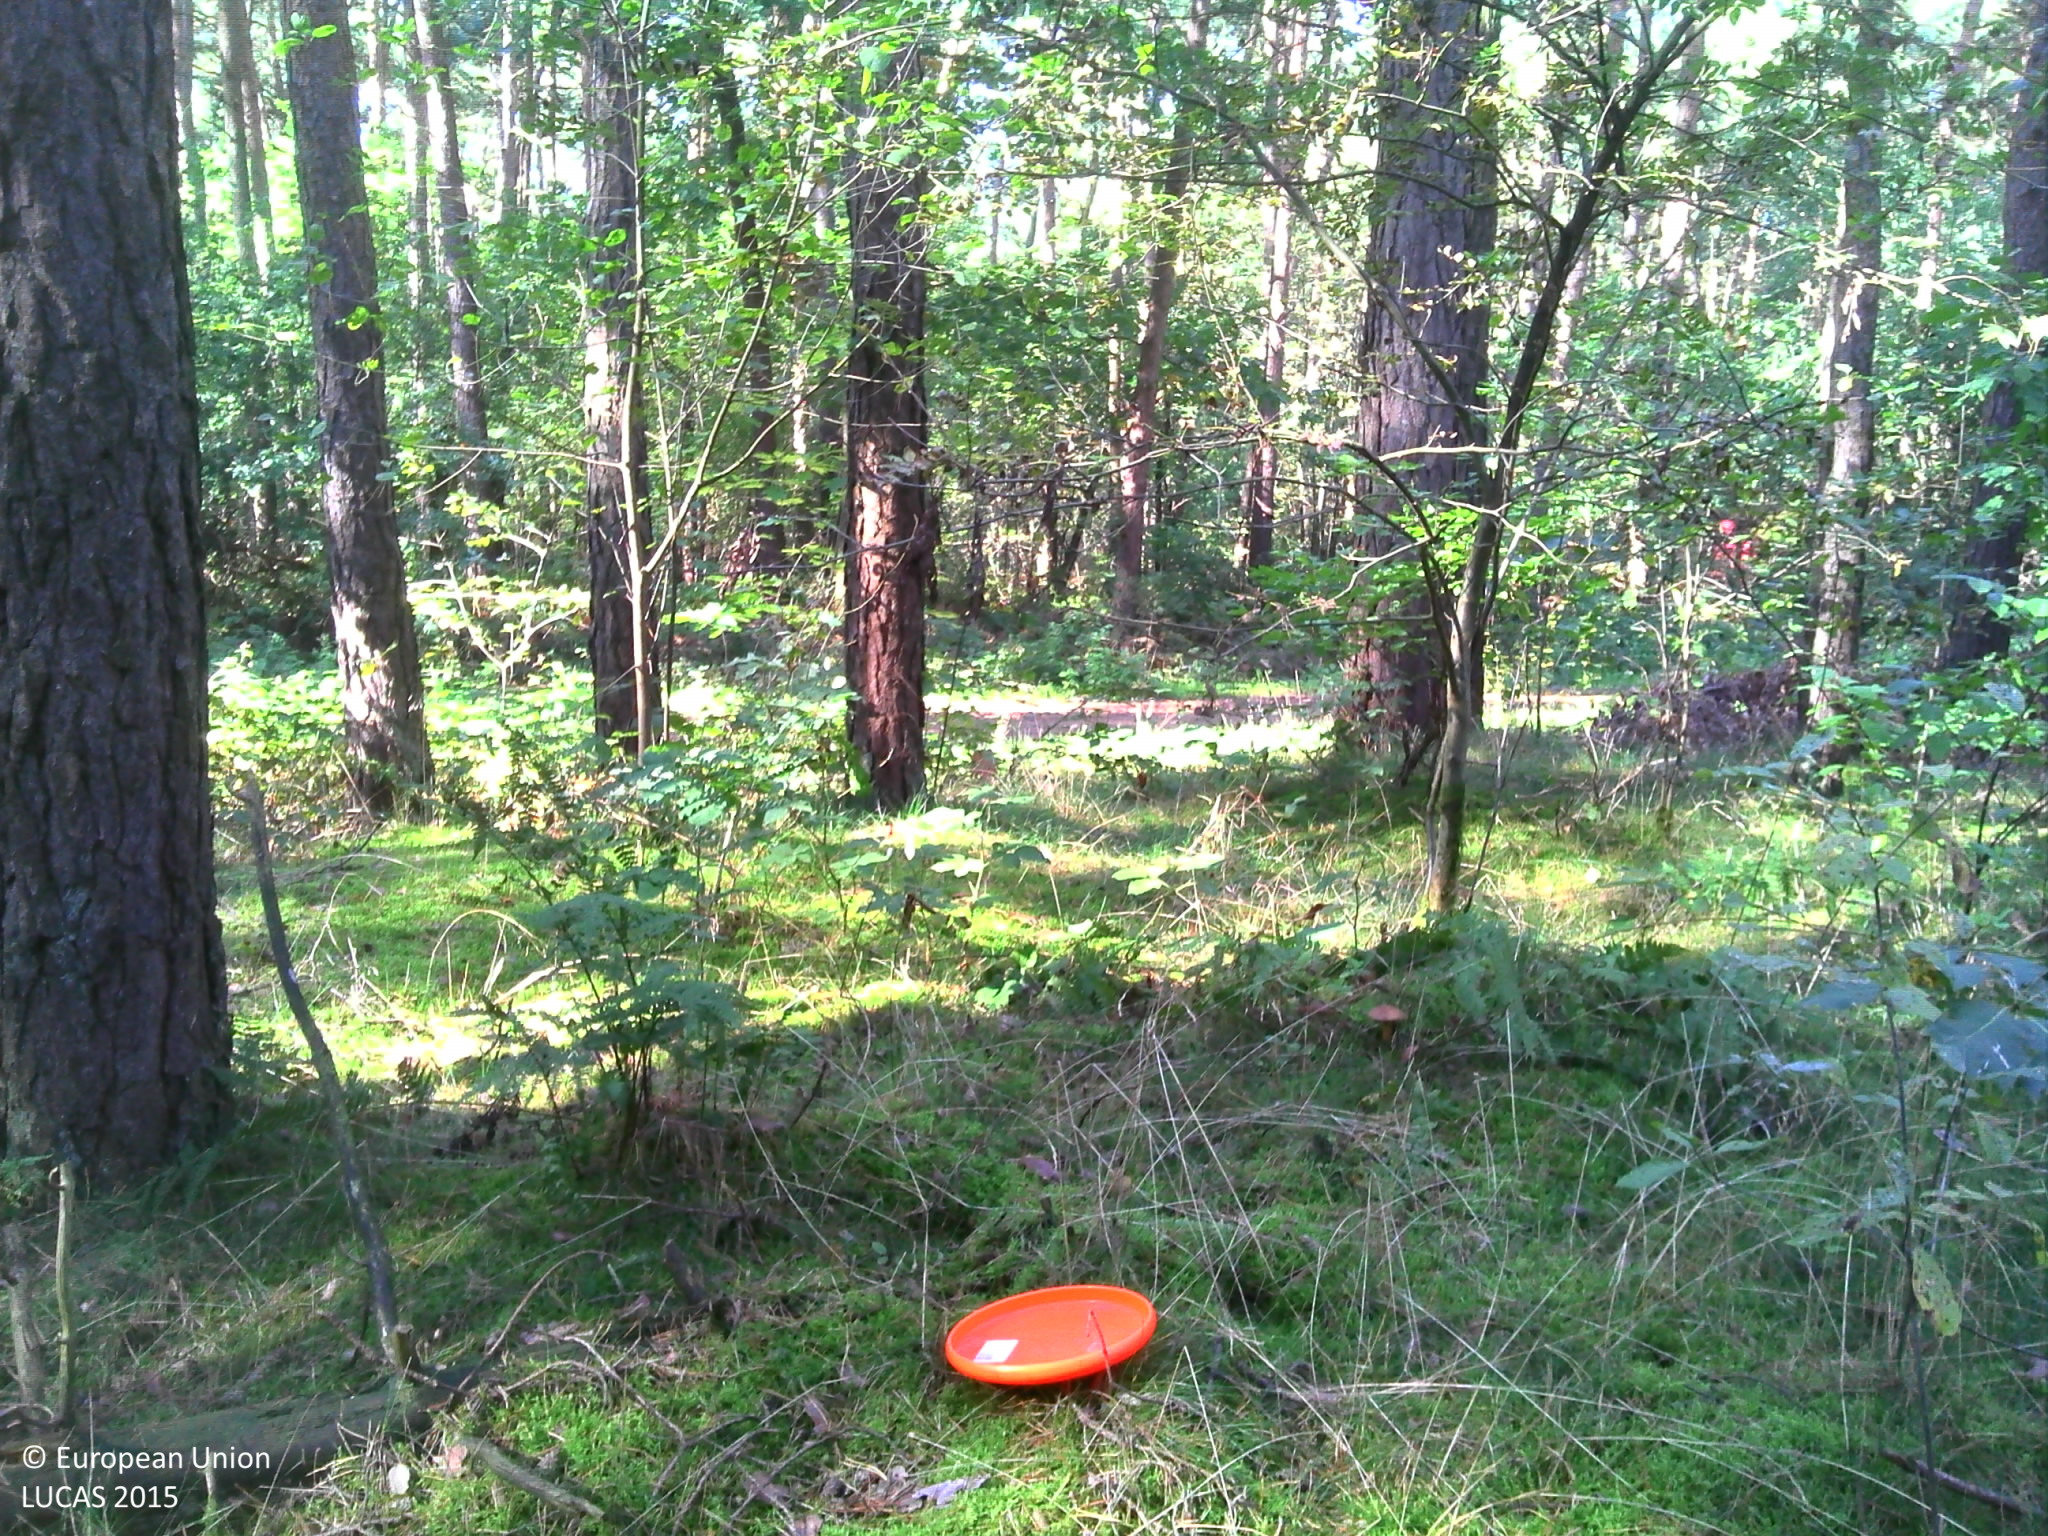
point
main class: Woodland
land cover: Pine dominated coniferous woodland
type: exotic forest
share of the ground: > 75 %
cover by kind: coniferous forest trees 100 %
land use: Forestry
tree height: > 5 m
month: September
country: BE
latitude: 51.2354
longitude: 4.7688
